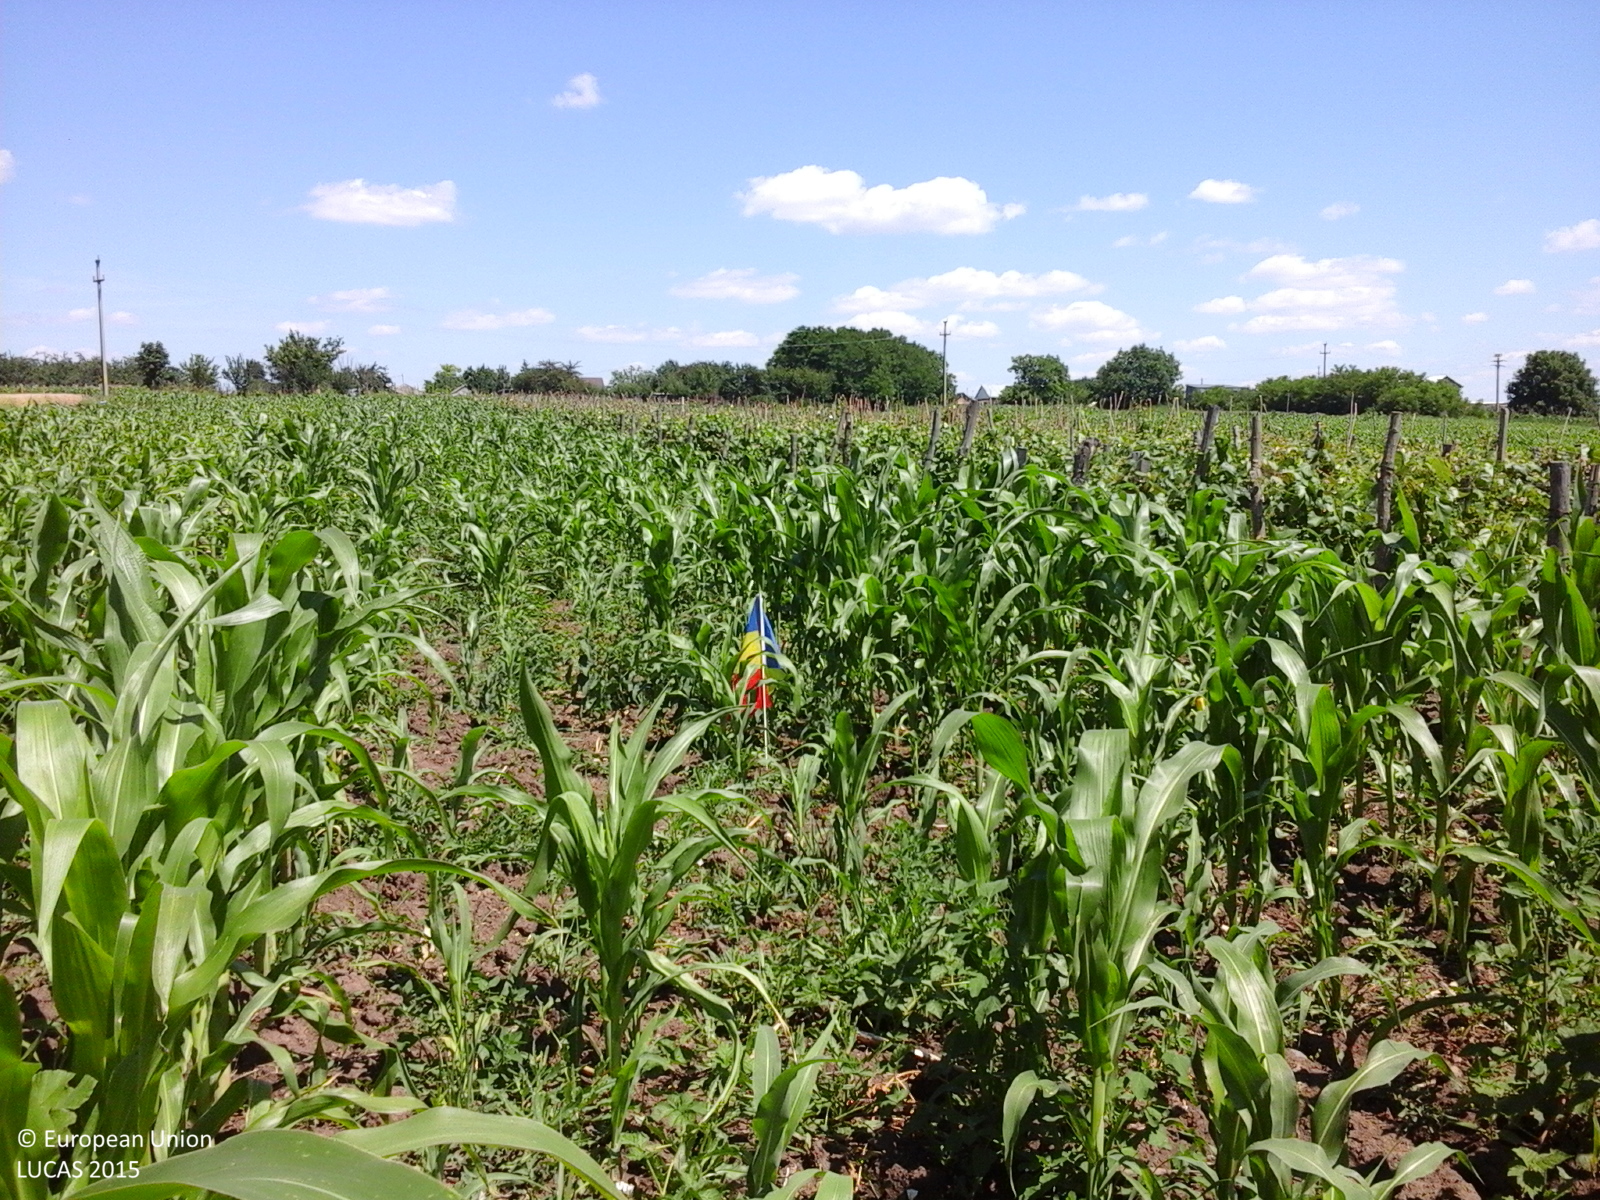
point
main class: Cropland
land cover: Maize
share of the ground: > 75 %
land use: Agriculture (excluding fallow land and kitchen gardens)
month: June
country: RO
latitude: 47.1885
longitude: 27.0888
